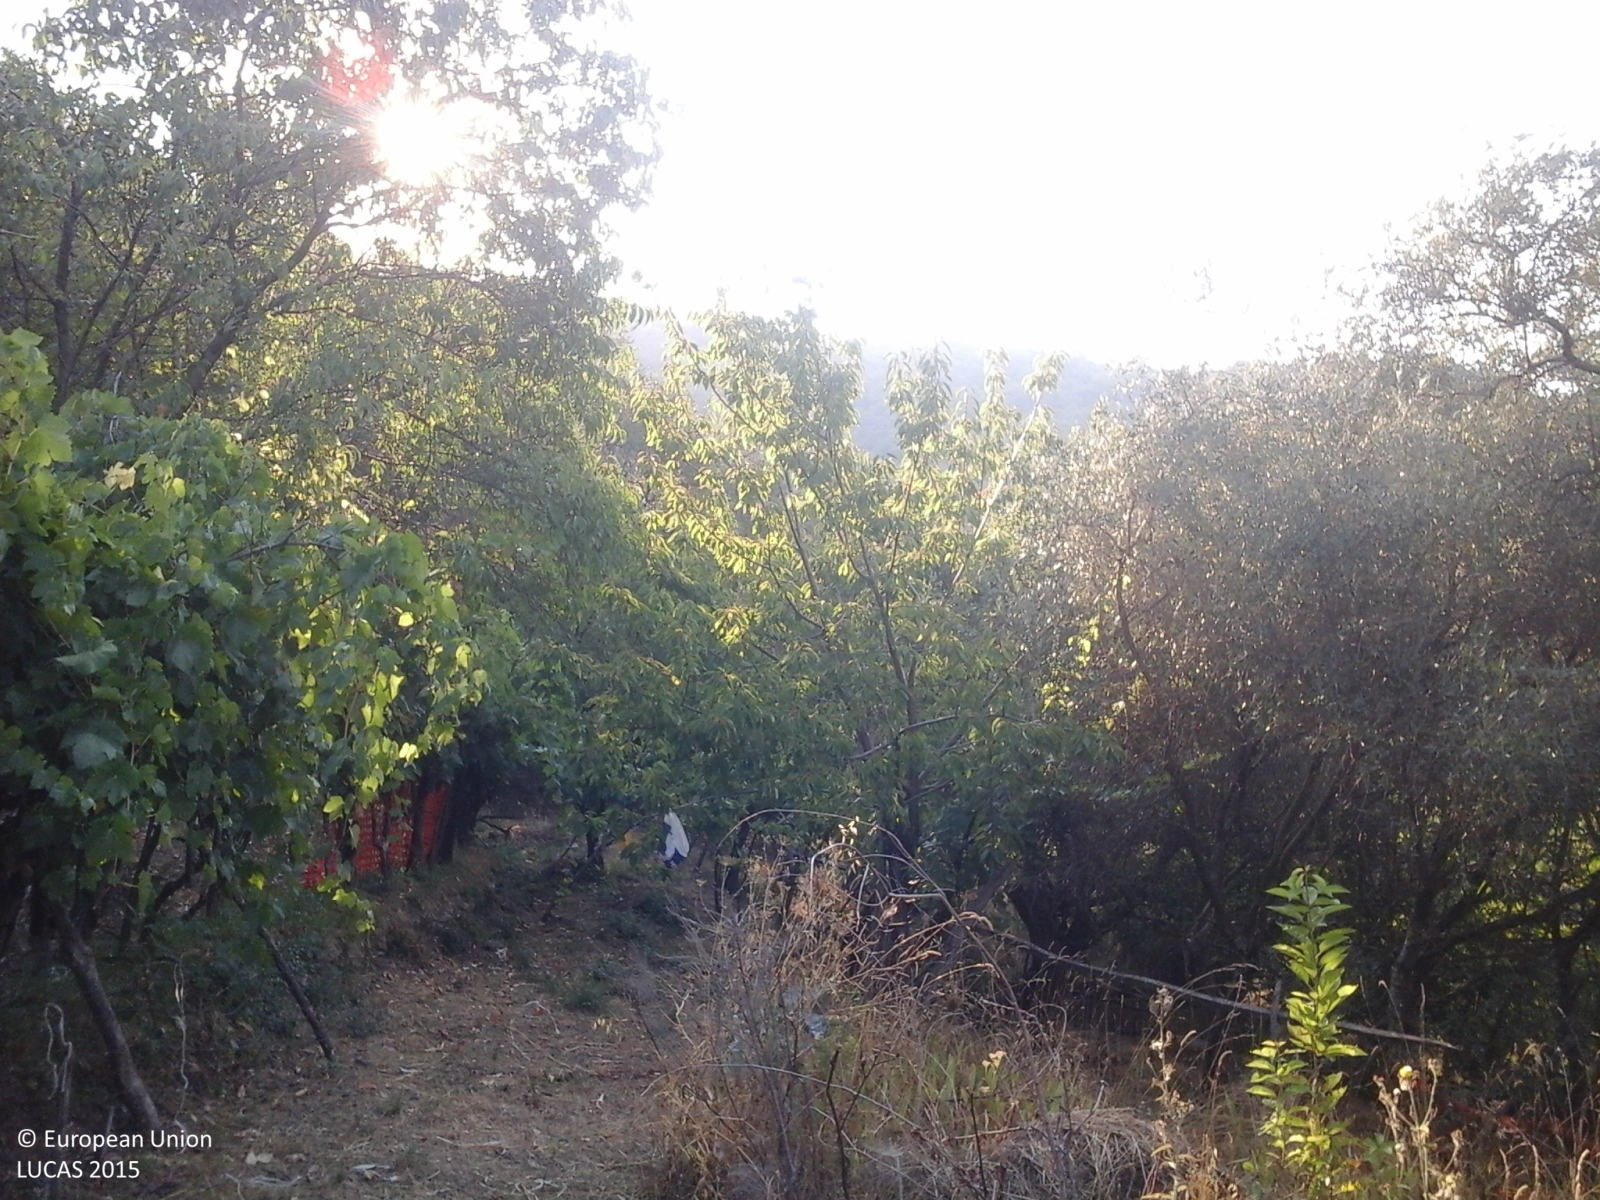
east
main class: Cropland
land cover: Olive groves
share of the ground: 50 - 75 %
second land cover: Grassland without tree/shrub cover
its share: 25 - 50 %
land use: Agriculture (excluding fallow land and kitchen gardens)
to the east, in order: Olive groves; Grassland without tree/shrub cover; Olive groves; Grassland with sparse tree/shrub cover; Dry stone walls; Olive groves; Grassland with sparse tree/shrub cover; Dry stone walls; Olive groves; Grassland with sparse tree/shrub cover; Dry stone walls; Olive groves; Grassland with sparse tree/shrub cover; Paved roads, cycling and walking lanes; Broadleaved woodland
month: August
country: IT
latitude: 44.3127
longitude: 9.3871
